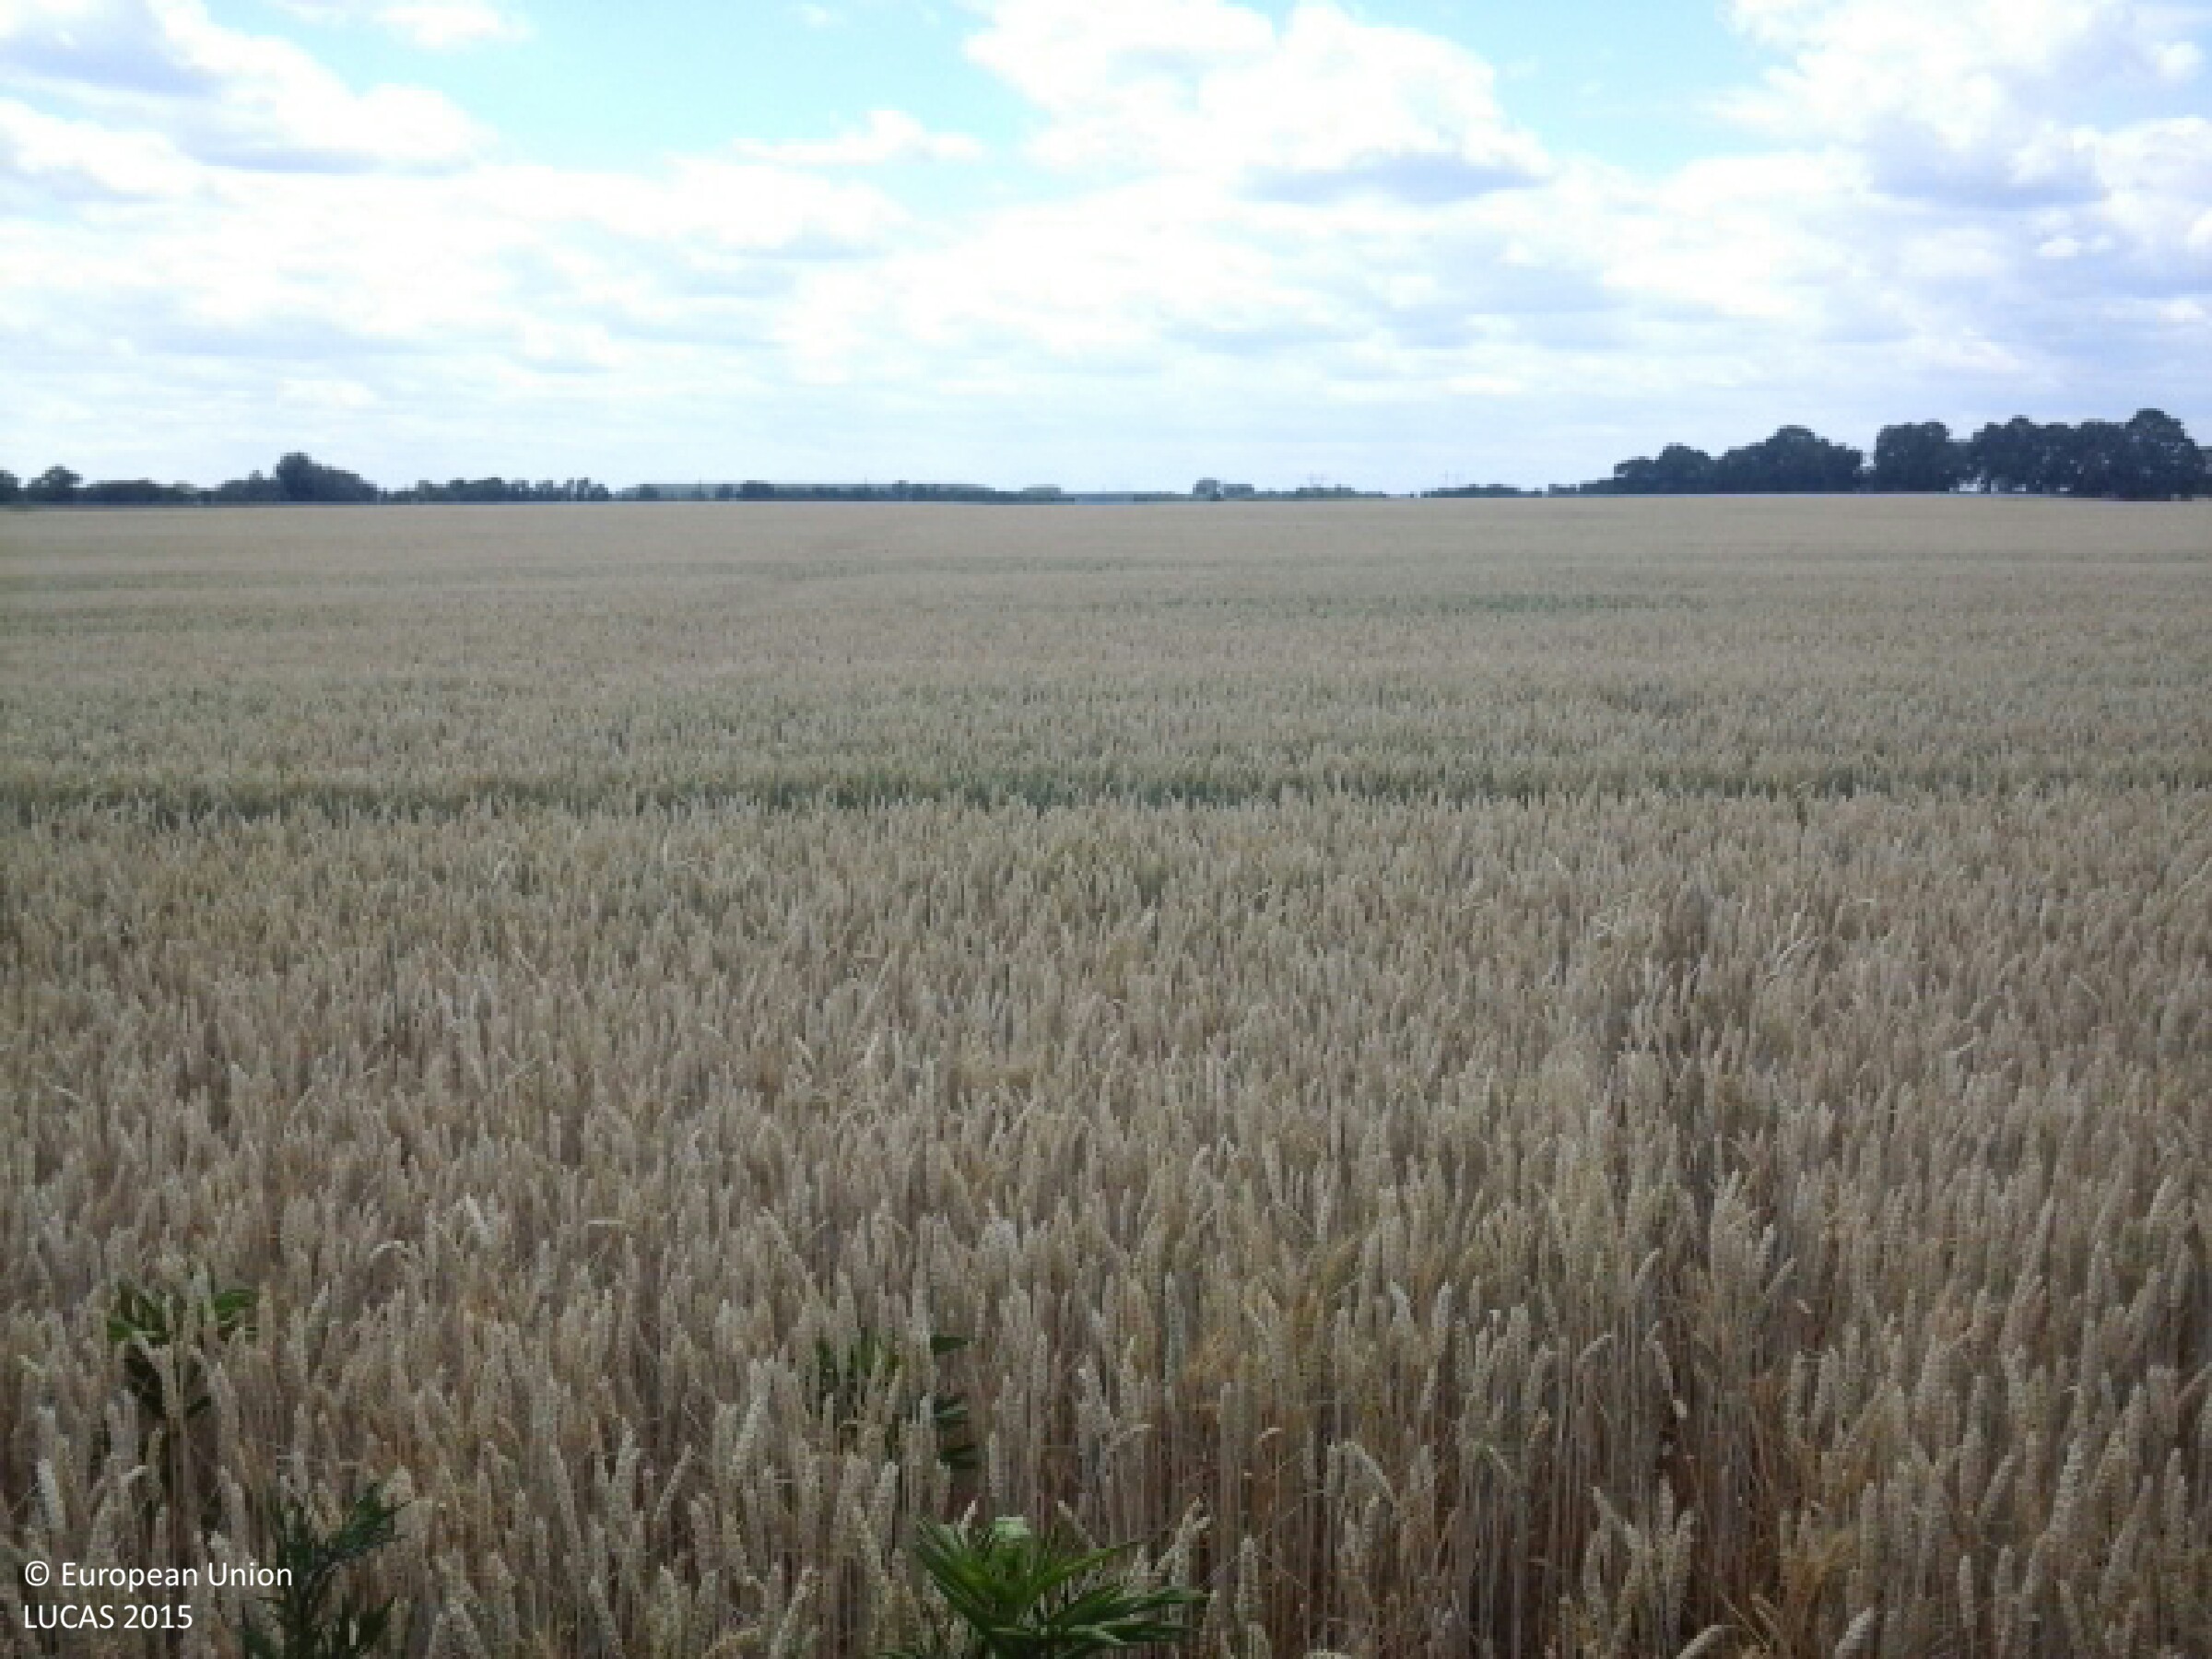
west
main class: Grassland
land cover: Spontaneously vegetated surfaces
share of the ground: > 75 %
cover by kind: herbaceous plants 95 %, shrubs 5 %
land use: Semi-natural and natural areas not in use
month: June
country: HU
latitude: 48.0697
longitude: 21.7108
